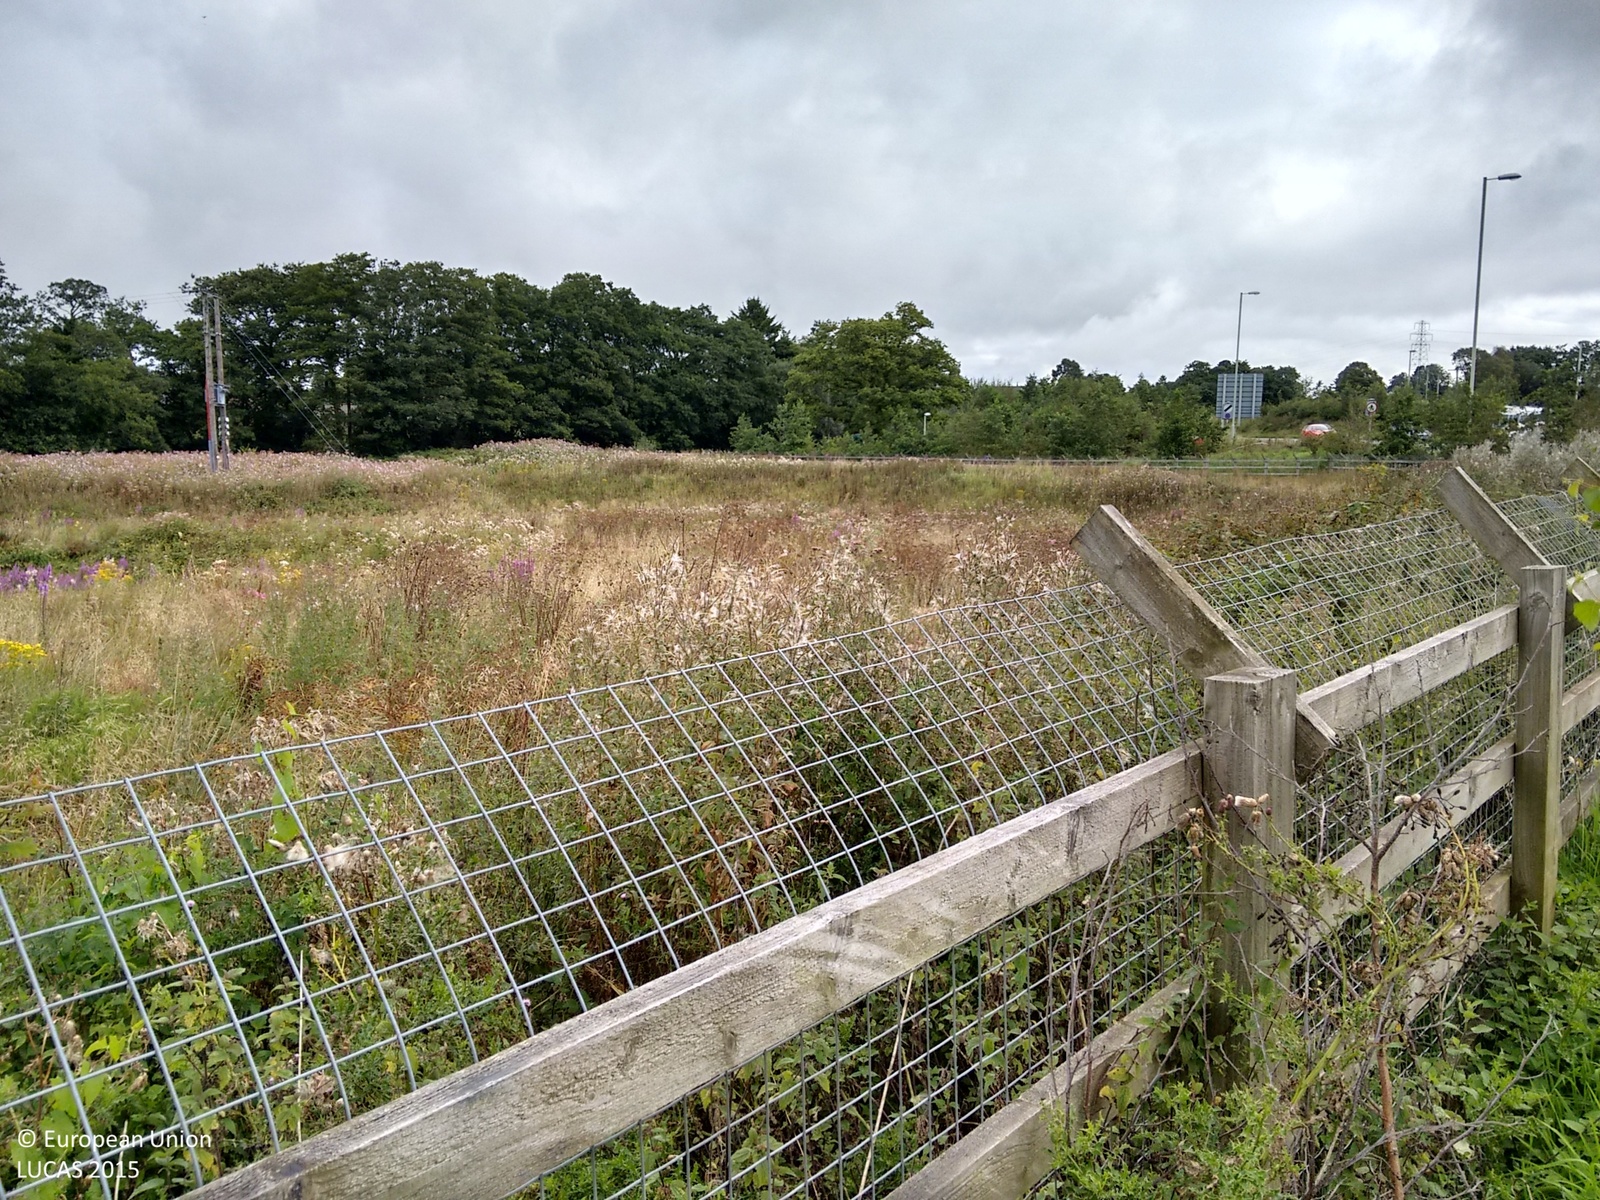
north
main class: Grassland
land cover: Grassland without tree/shrub cover
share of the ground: > 75 %
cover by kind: herbaceous plants 100 %
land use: Road transport
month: September
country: GB
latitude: 51.5479
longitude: -3.3339
